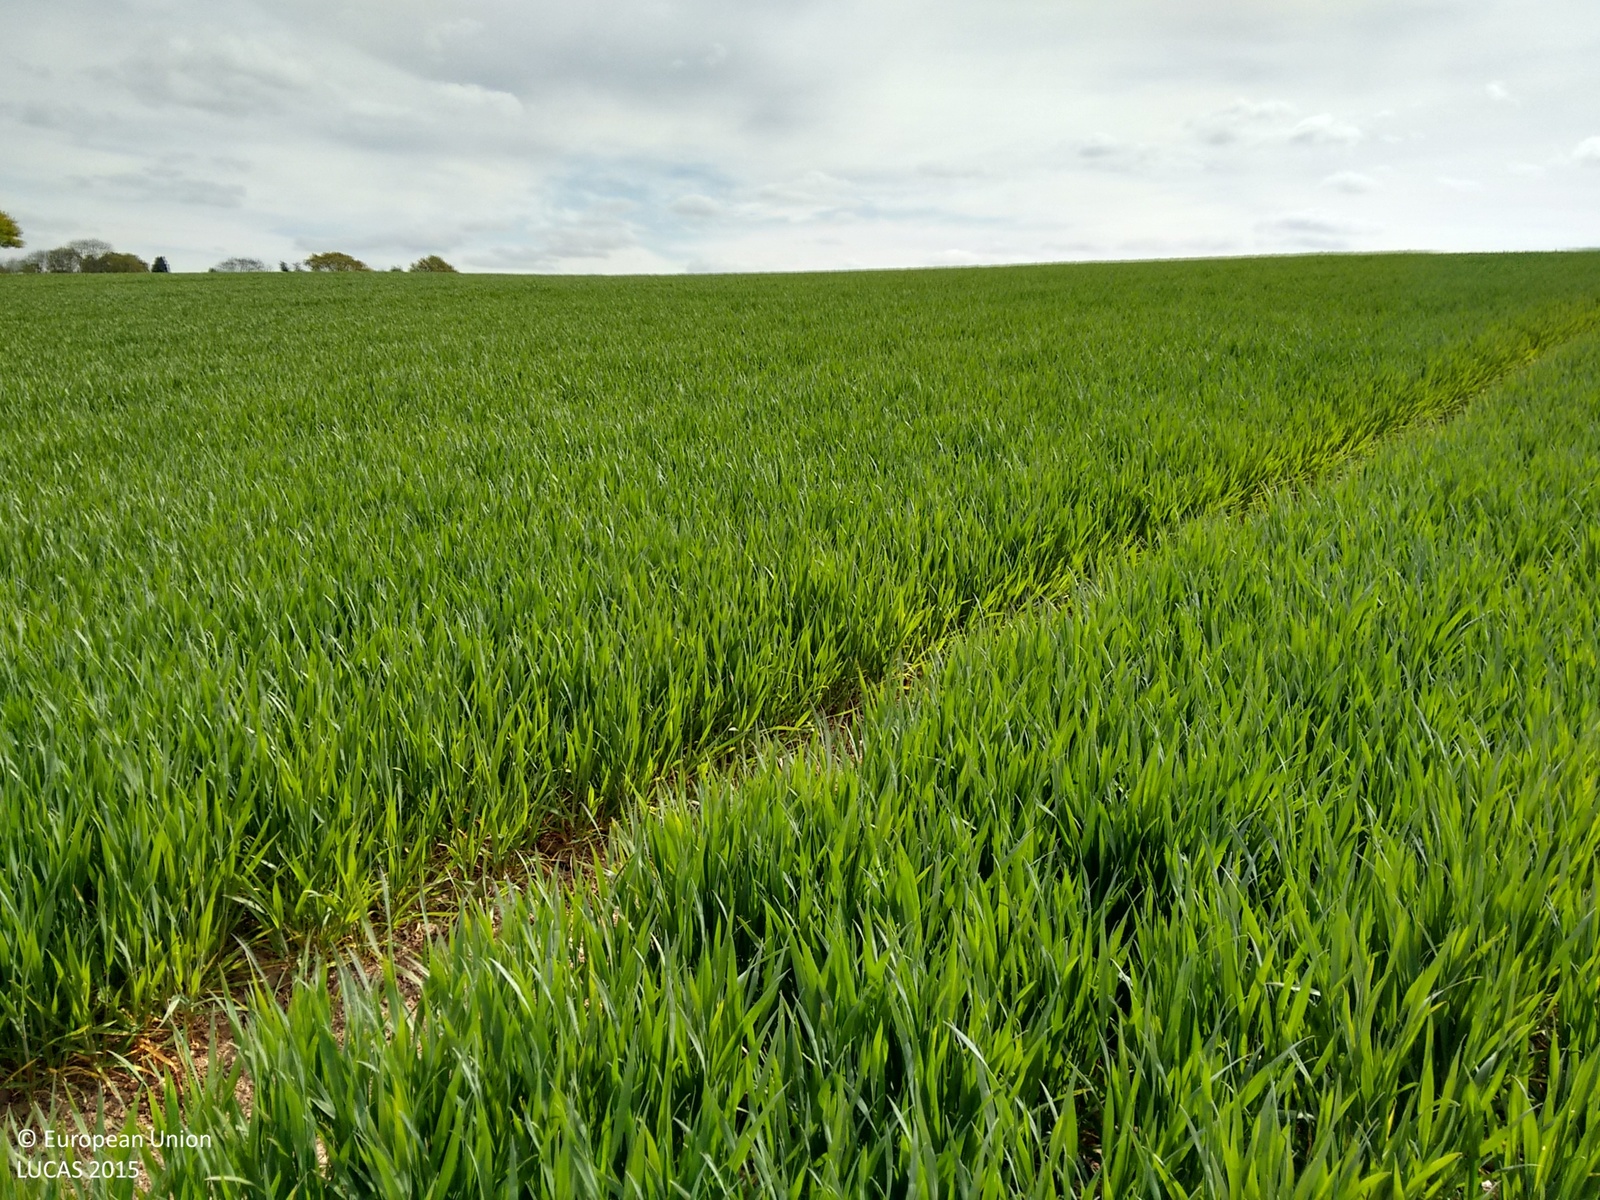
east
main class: Cropland
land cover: Common wheat
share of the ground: > 75 %
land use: Agriculture (excluding fallow land and kitchen gardens)
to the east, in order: Common wheat
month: May
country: GB
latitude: 52.2660
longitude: -1.9113
